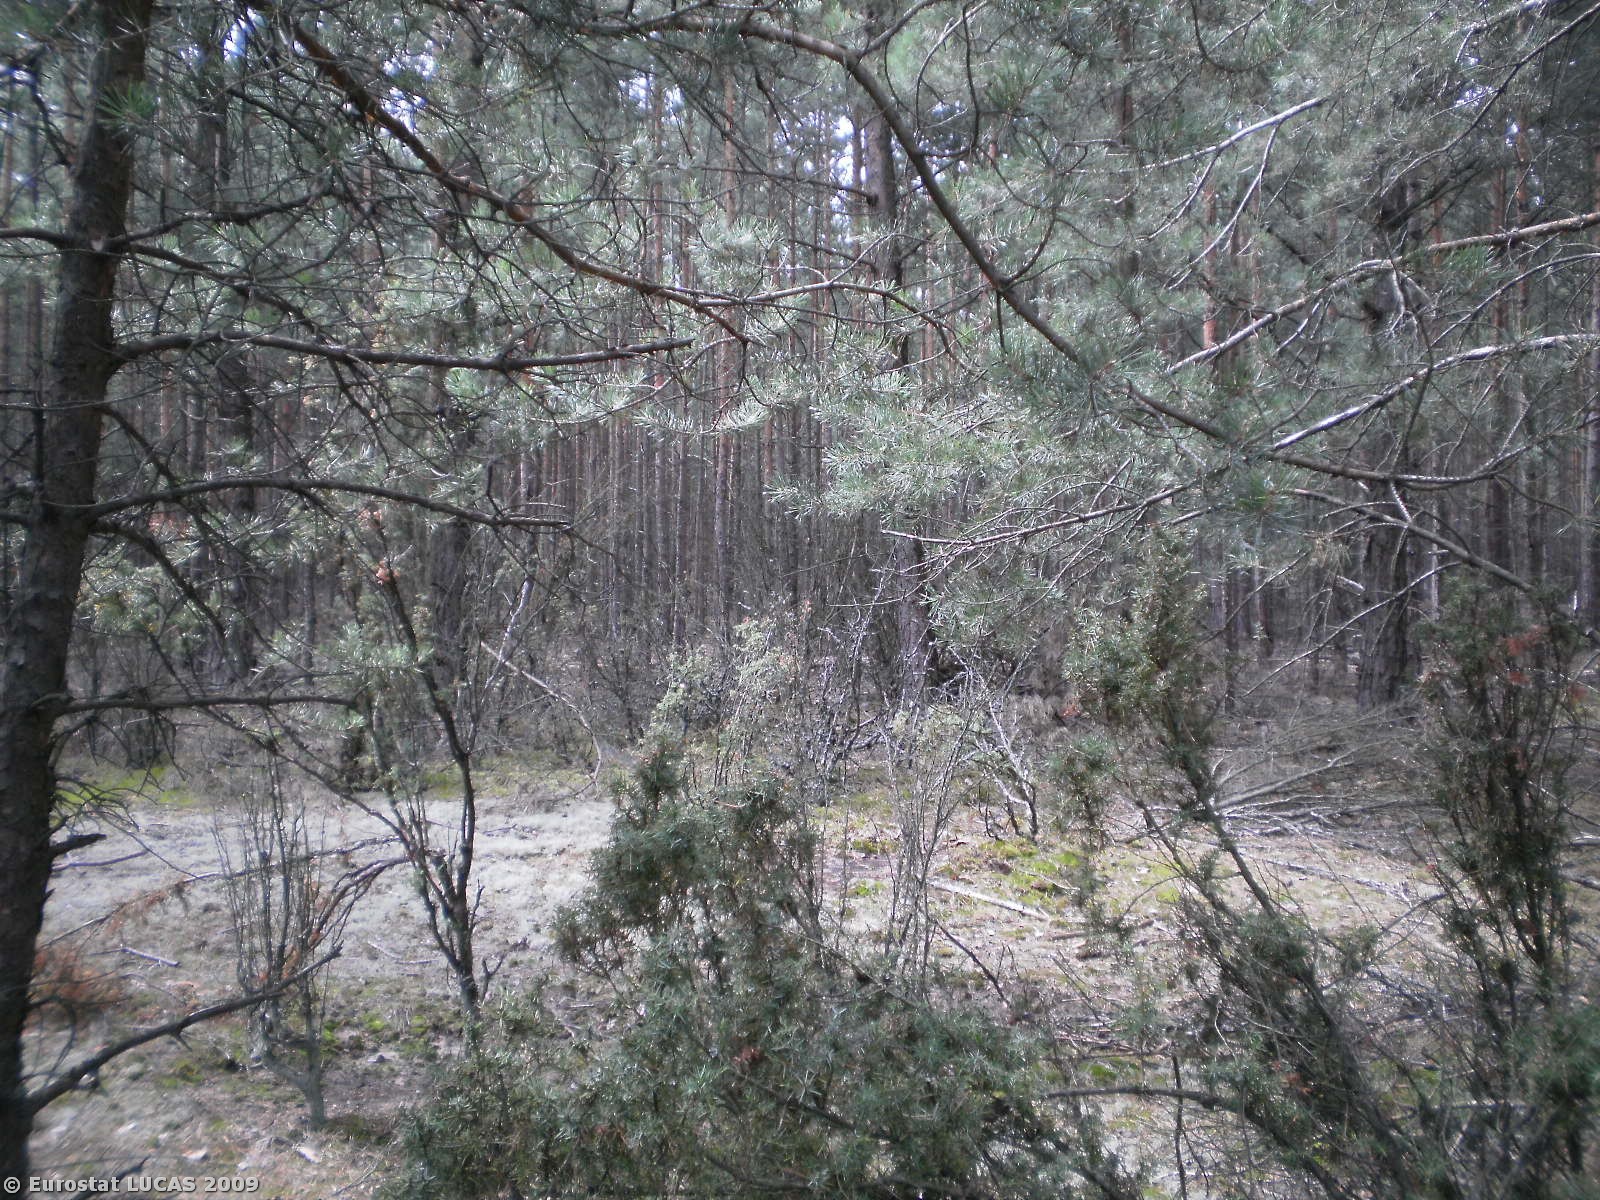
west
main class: Woodland
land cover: Coniferous woodland
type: hemiboreal forest and nemoral coniferous forest and mixed broadleaved-coniferous forest
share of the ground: > 75 %
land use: Forestry
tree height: > 5 m
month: August
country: PL
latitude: 52.9182
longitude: 21.1858
